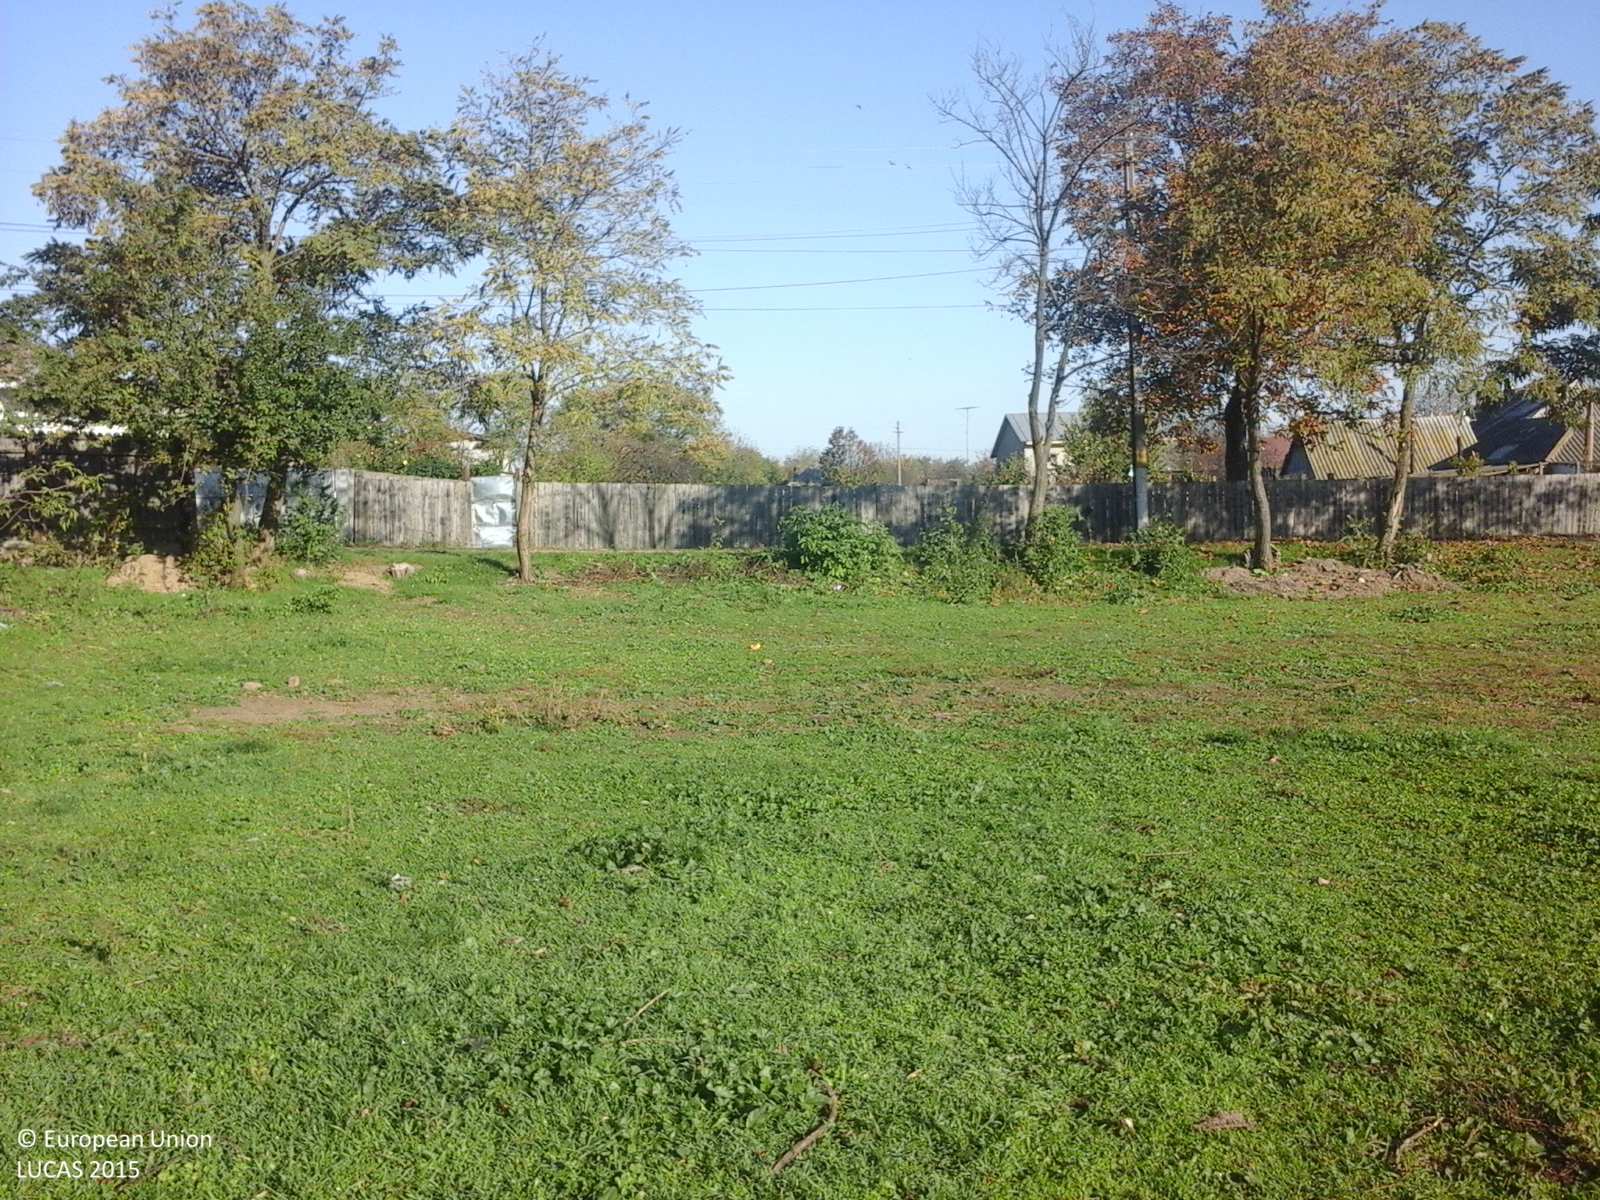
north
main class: Cropland
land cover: Nuts trees
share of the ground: 50 - 75 %
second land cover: Grassland without tree/shrub cover
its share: 25 - 50 %
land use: Agriculture (excluding fallow land and kitchen gardens)
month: October
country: RO
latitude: 45.9185
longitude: 27.2070
